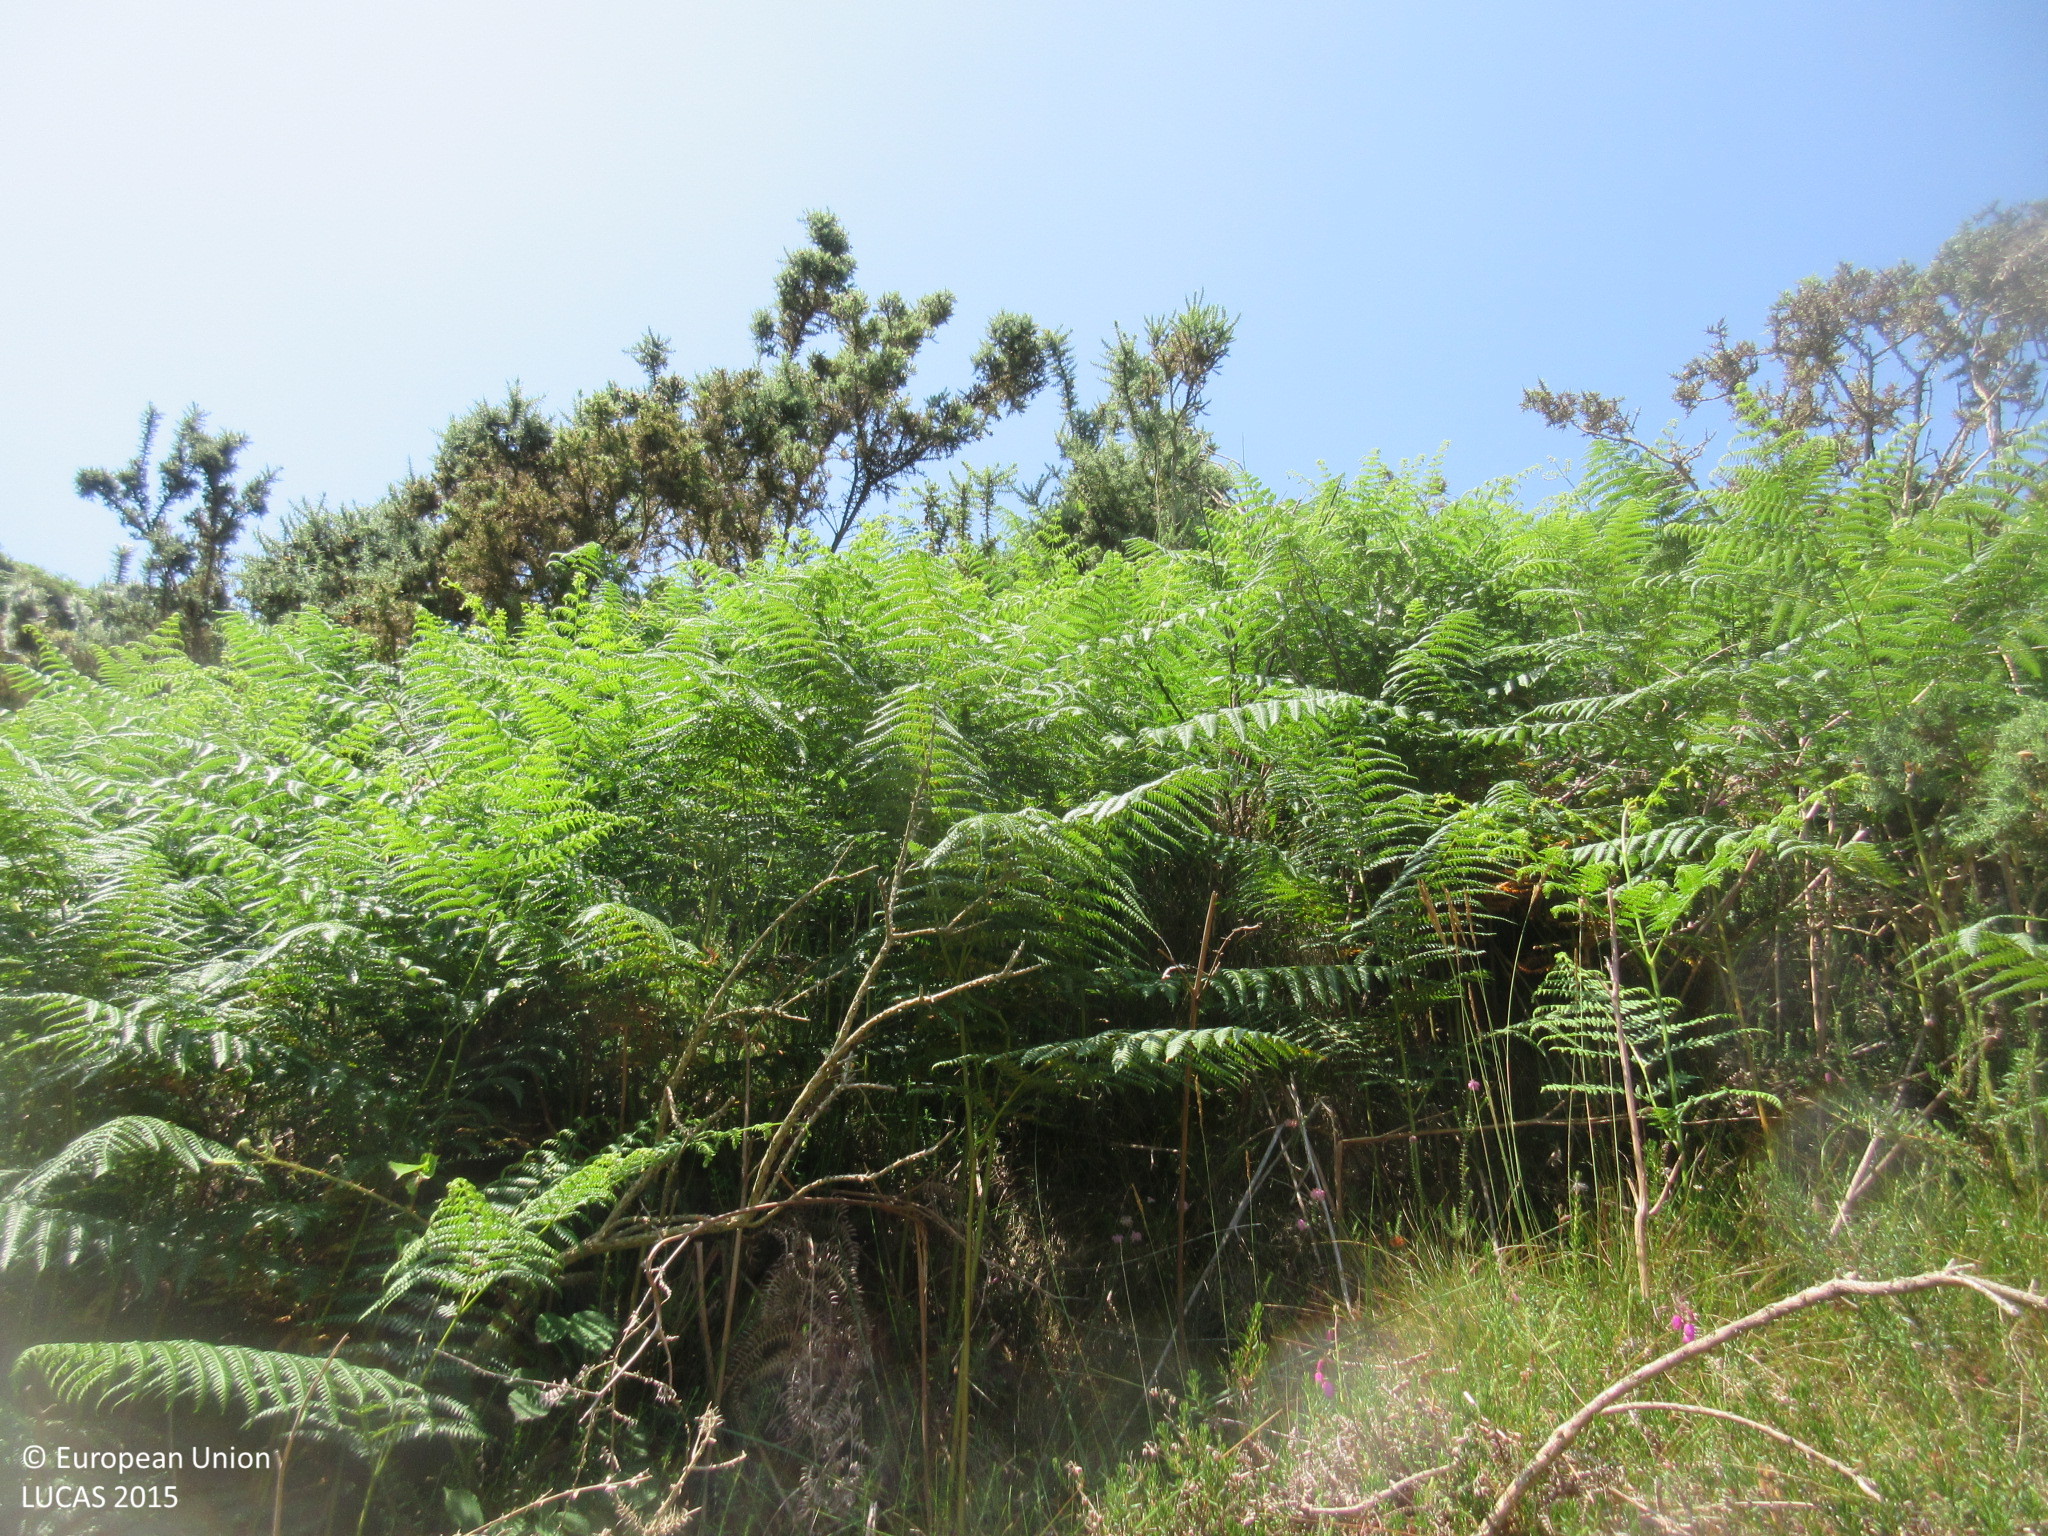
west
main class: Shrubland
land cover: Shrubland without tree cover
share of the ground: > 75 %
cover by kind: shrubs 100 %
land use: Agriculture (excluding fallow land and kitchen gardens)
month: July
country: ES
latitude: 43.4312
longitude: -6.6742
